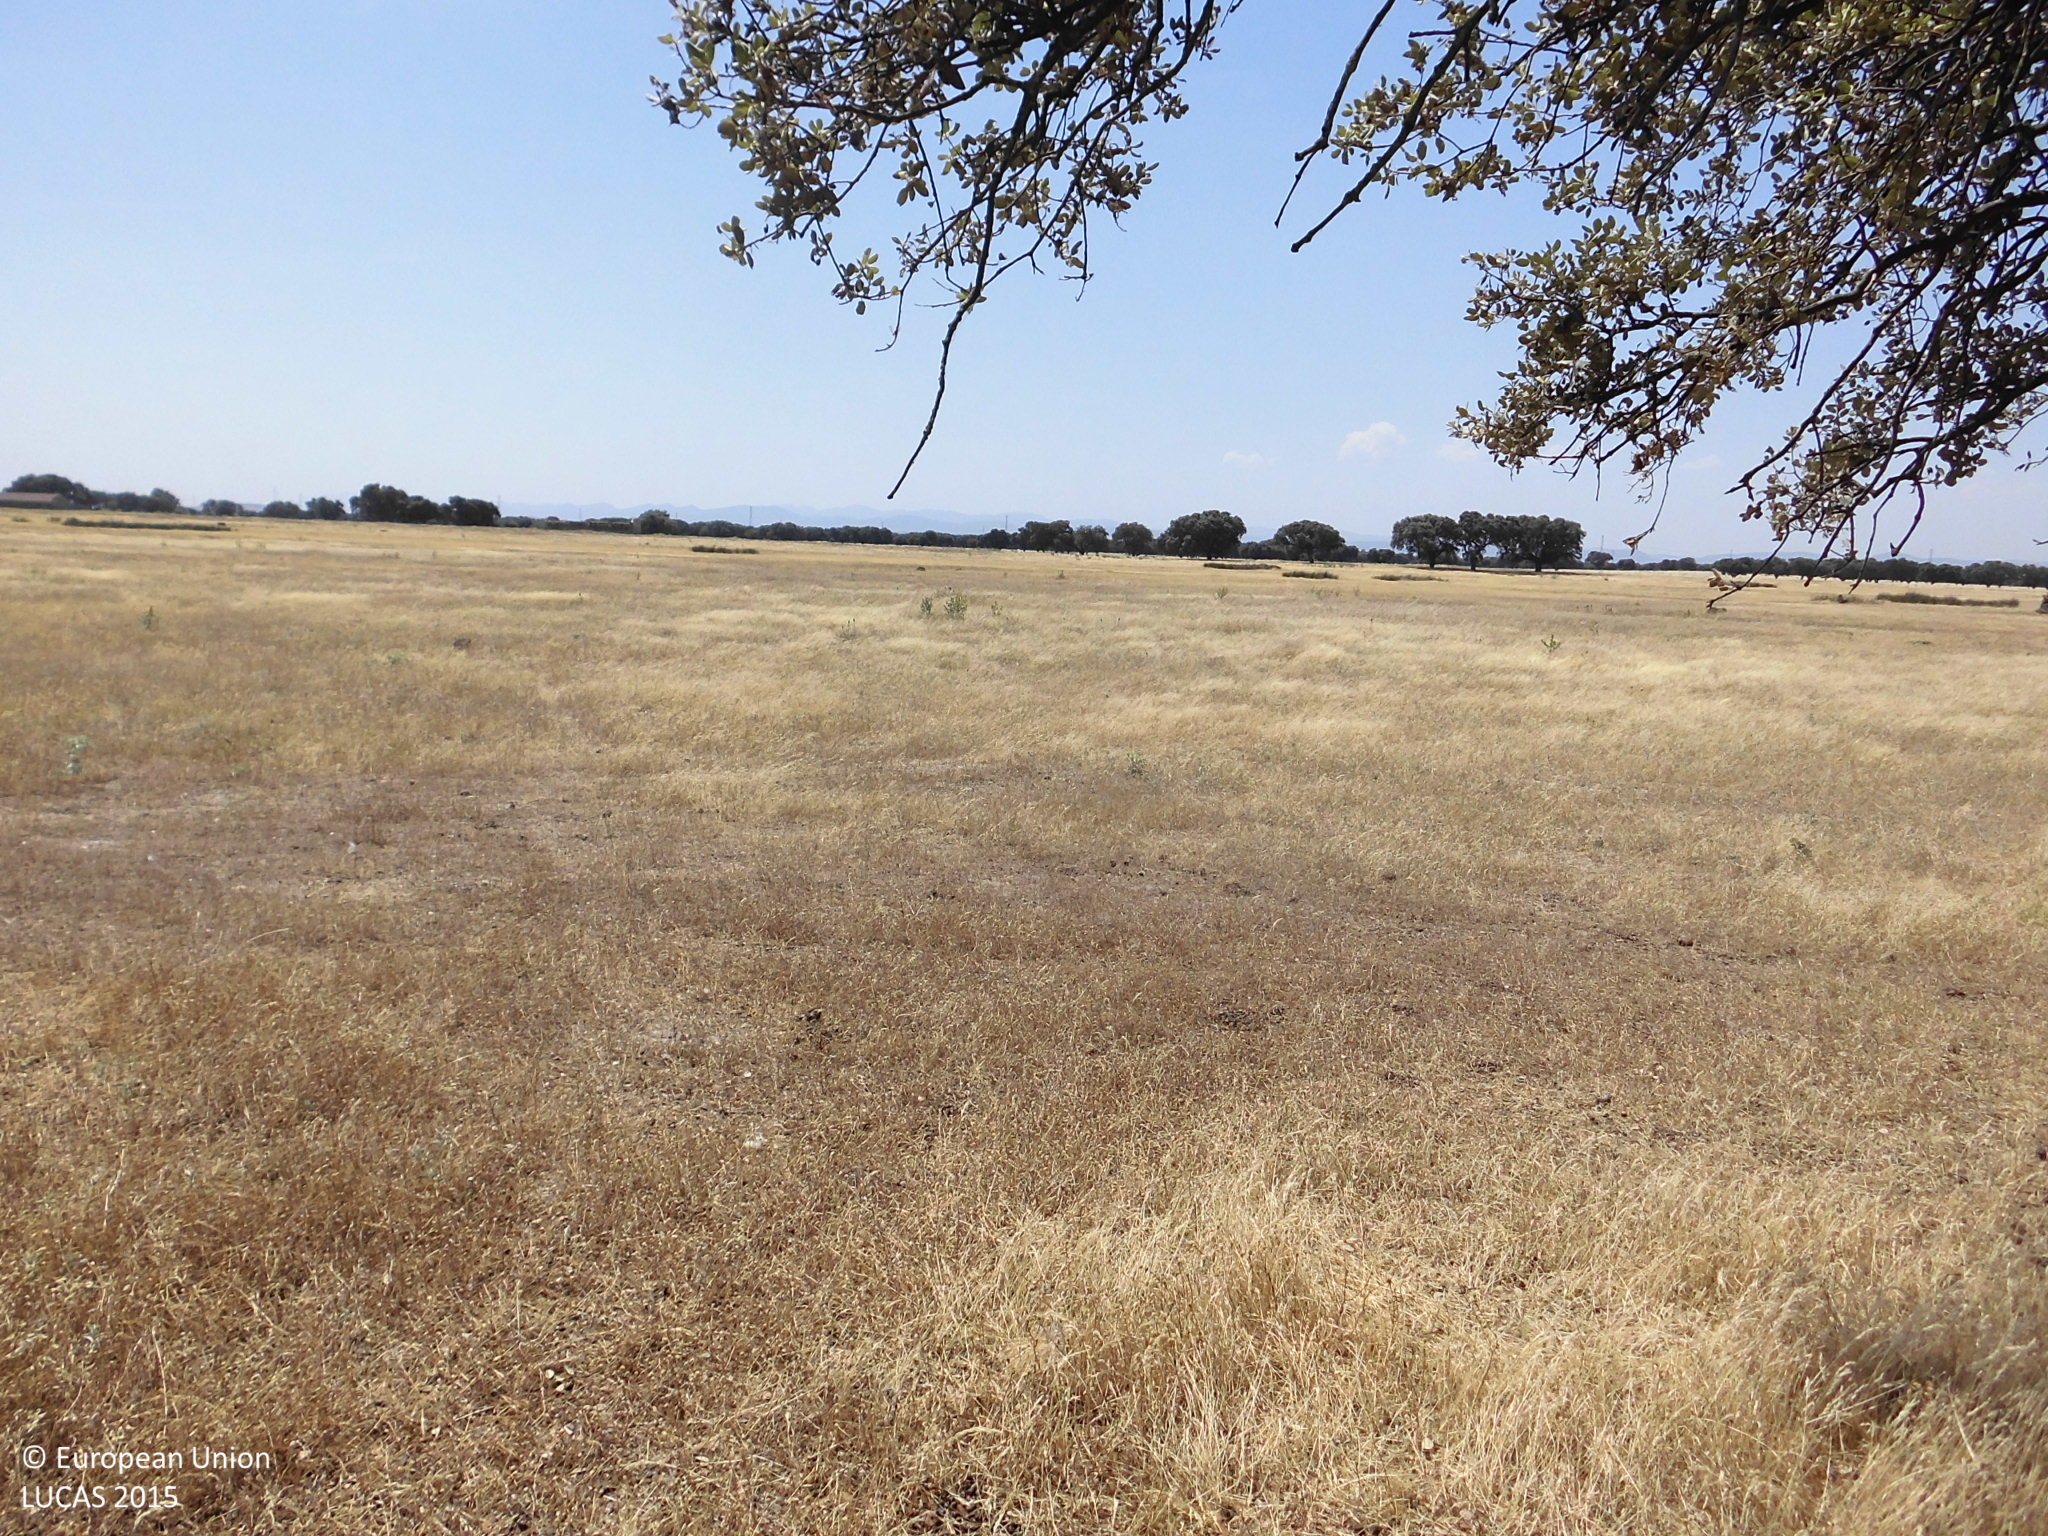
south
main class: Woodland
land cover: Broadleaved woodland
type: broadleaved evergreen forest
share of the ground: 10 - 25 %
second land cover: Grassland without tree/shrub cover
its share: > 75 %
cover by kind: herbaceous plants 90 %, broadleaved forest trees 10 %
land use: Forestry
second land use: Agriculture (excluding fallow land and kitchen gardens)
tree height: > 5 m
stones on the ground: < 10 %
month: June
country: ES
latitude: 39.9437
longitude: -5.4007
